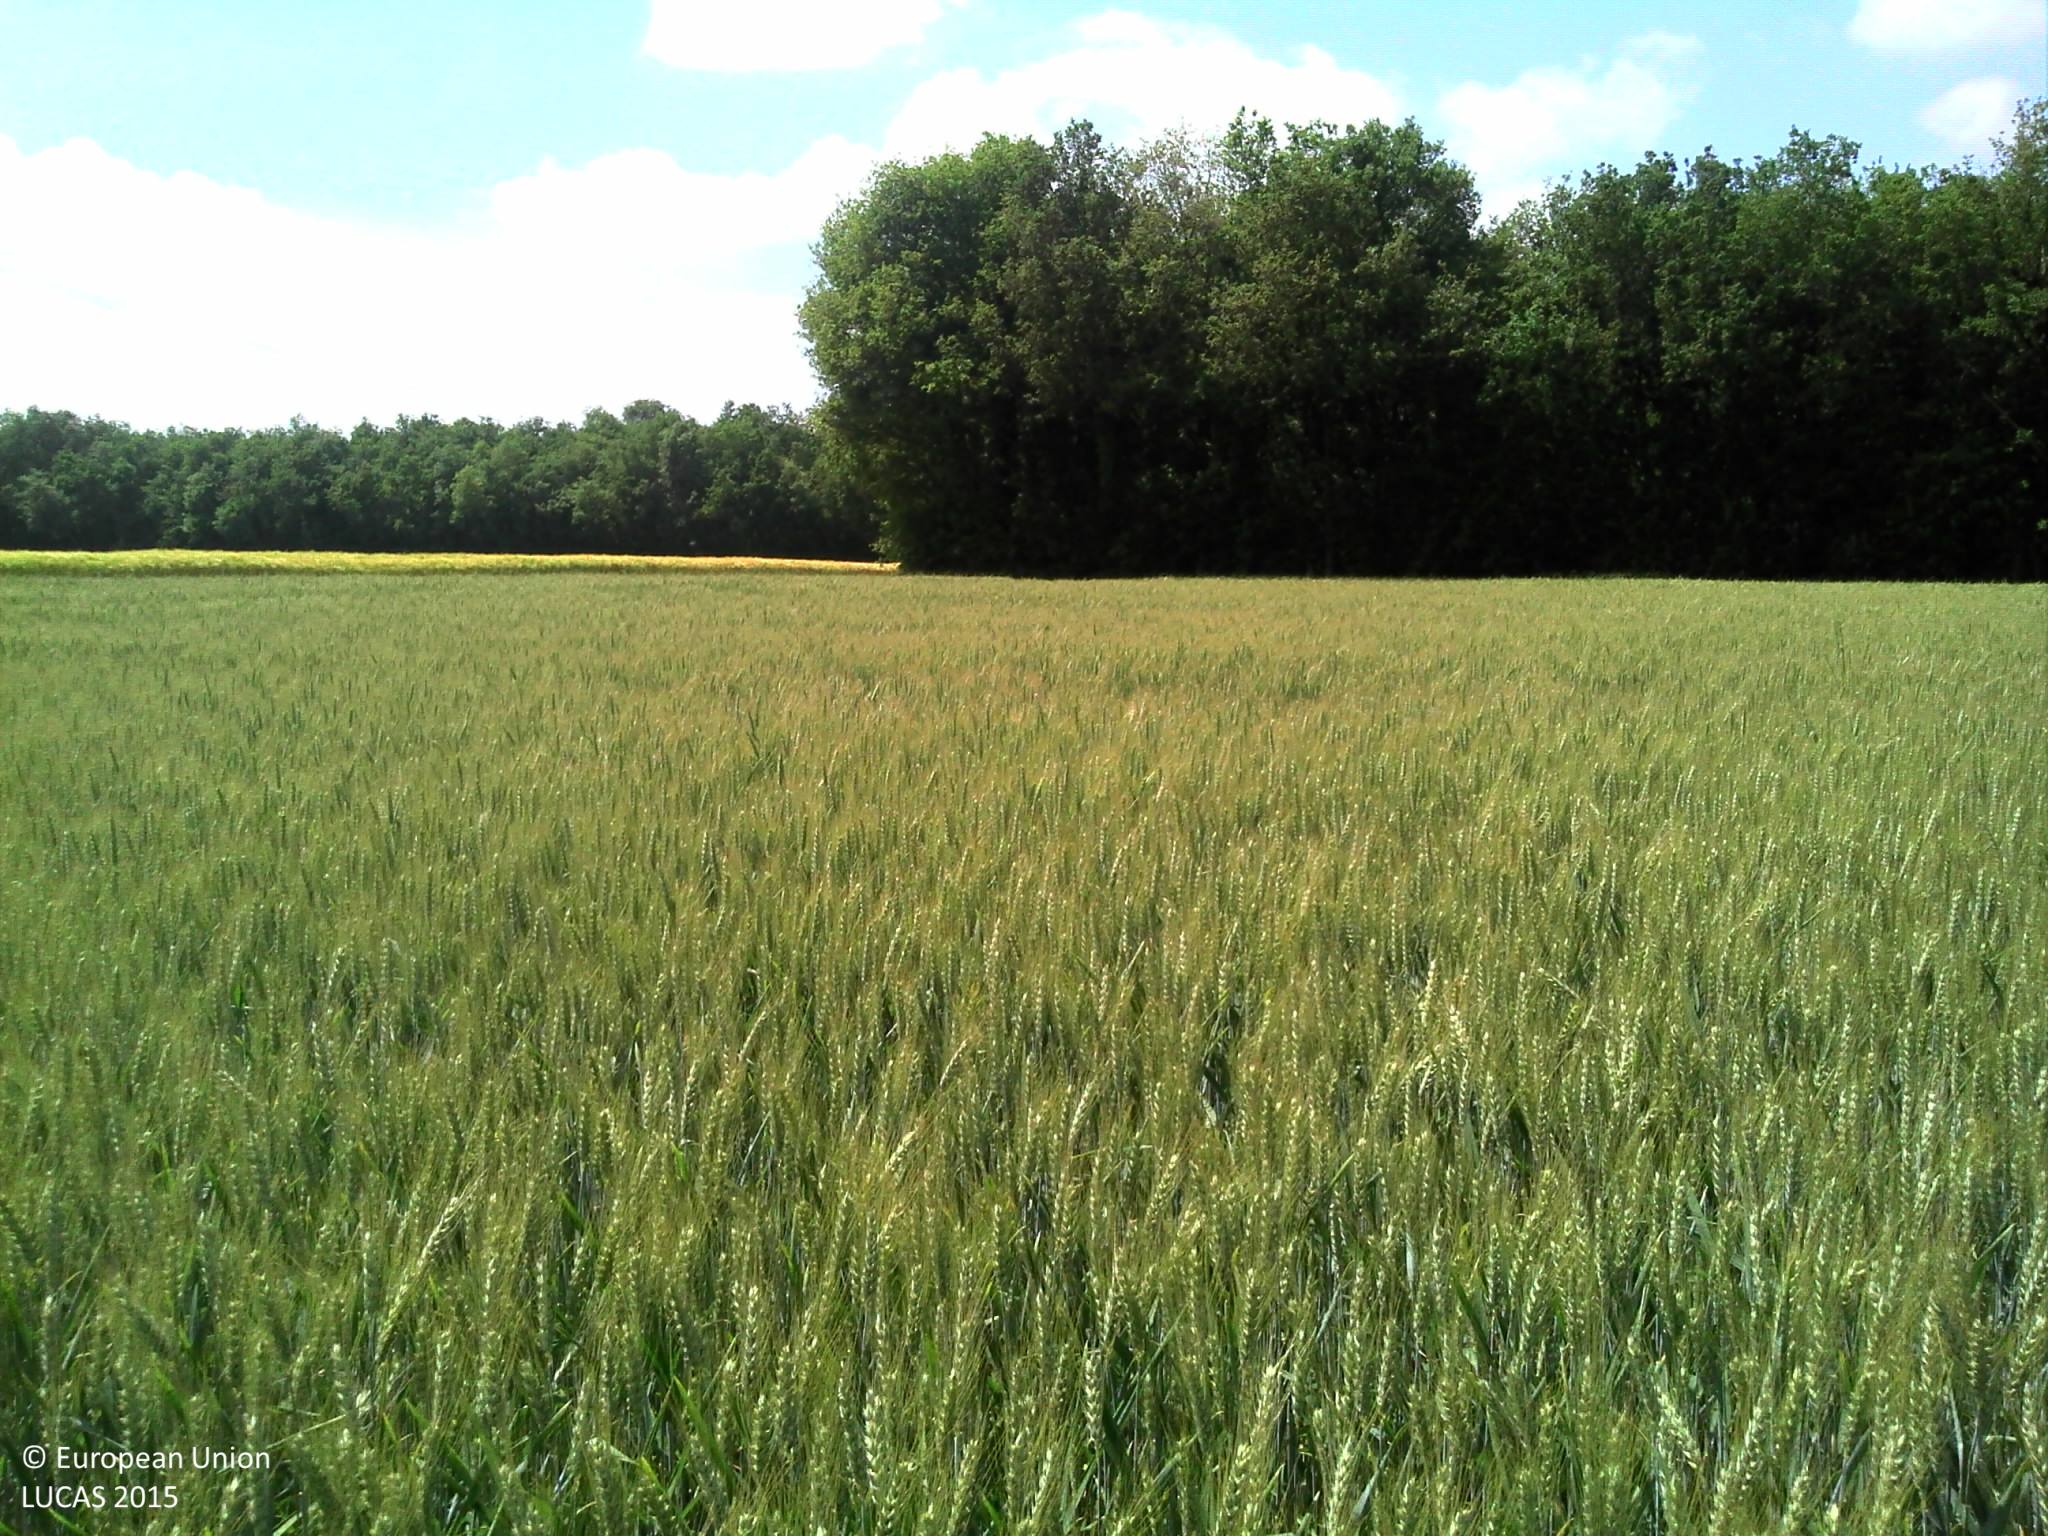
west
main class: Cropland
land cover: Durum wheat
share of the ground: > 75 %
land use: Agriculture (excluding fallow land and kitchen gardens)
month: May
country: FR
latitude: 47.0532
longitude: 0.1170
